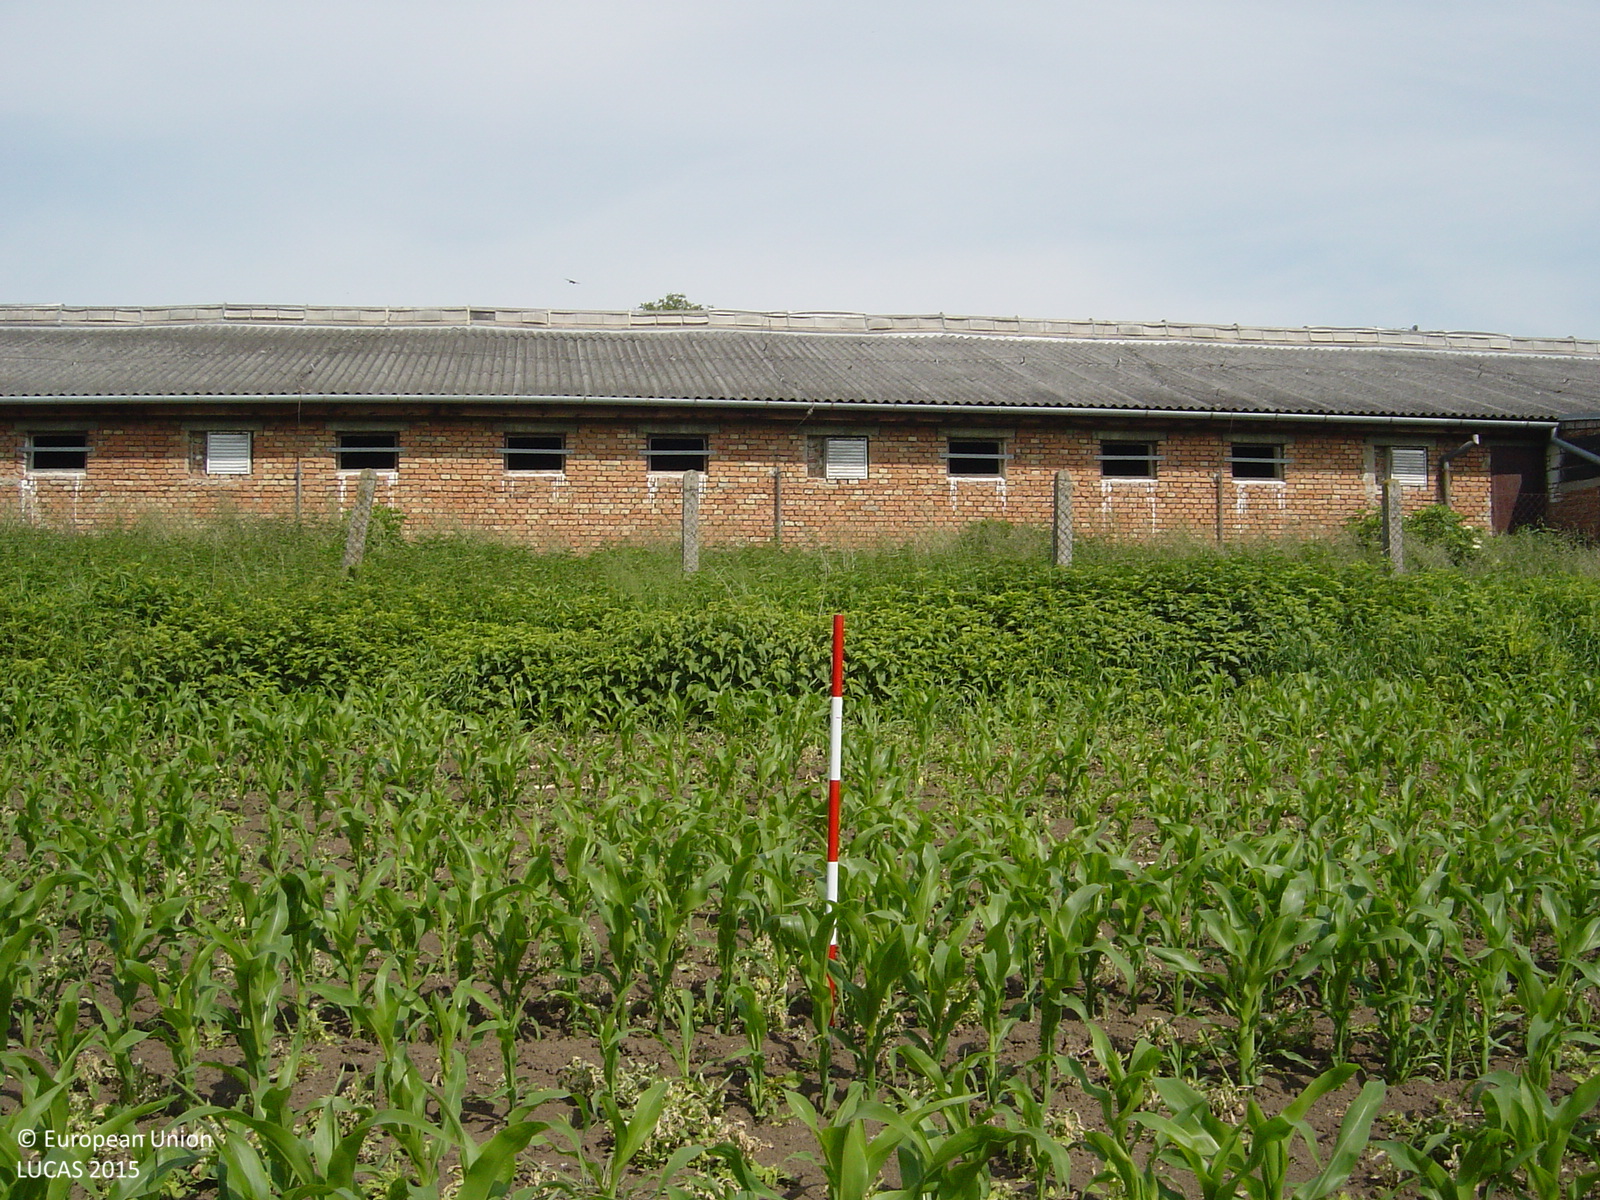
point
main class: Cropland
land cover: Maize
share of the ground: 25 - 50 %
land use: Agriculture (excluding fallow land and kitchen gardens)
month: June
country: CZ
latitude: 49.1701
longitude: 17.0730
